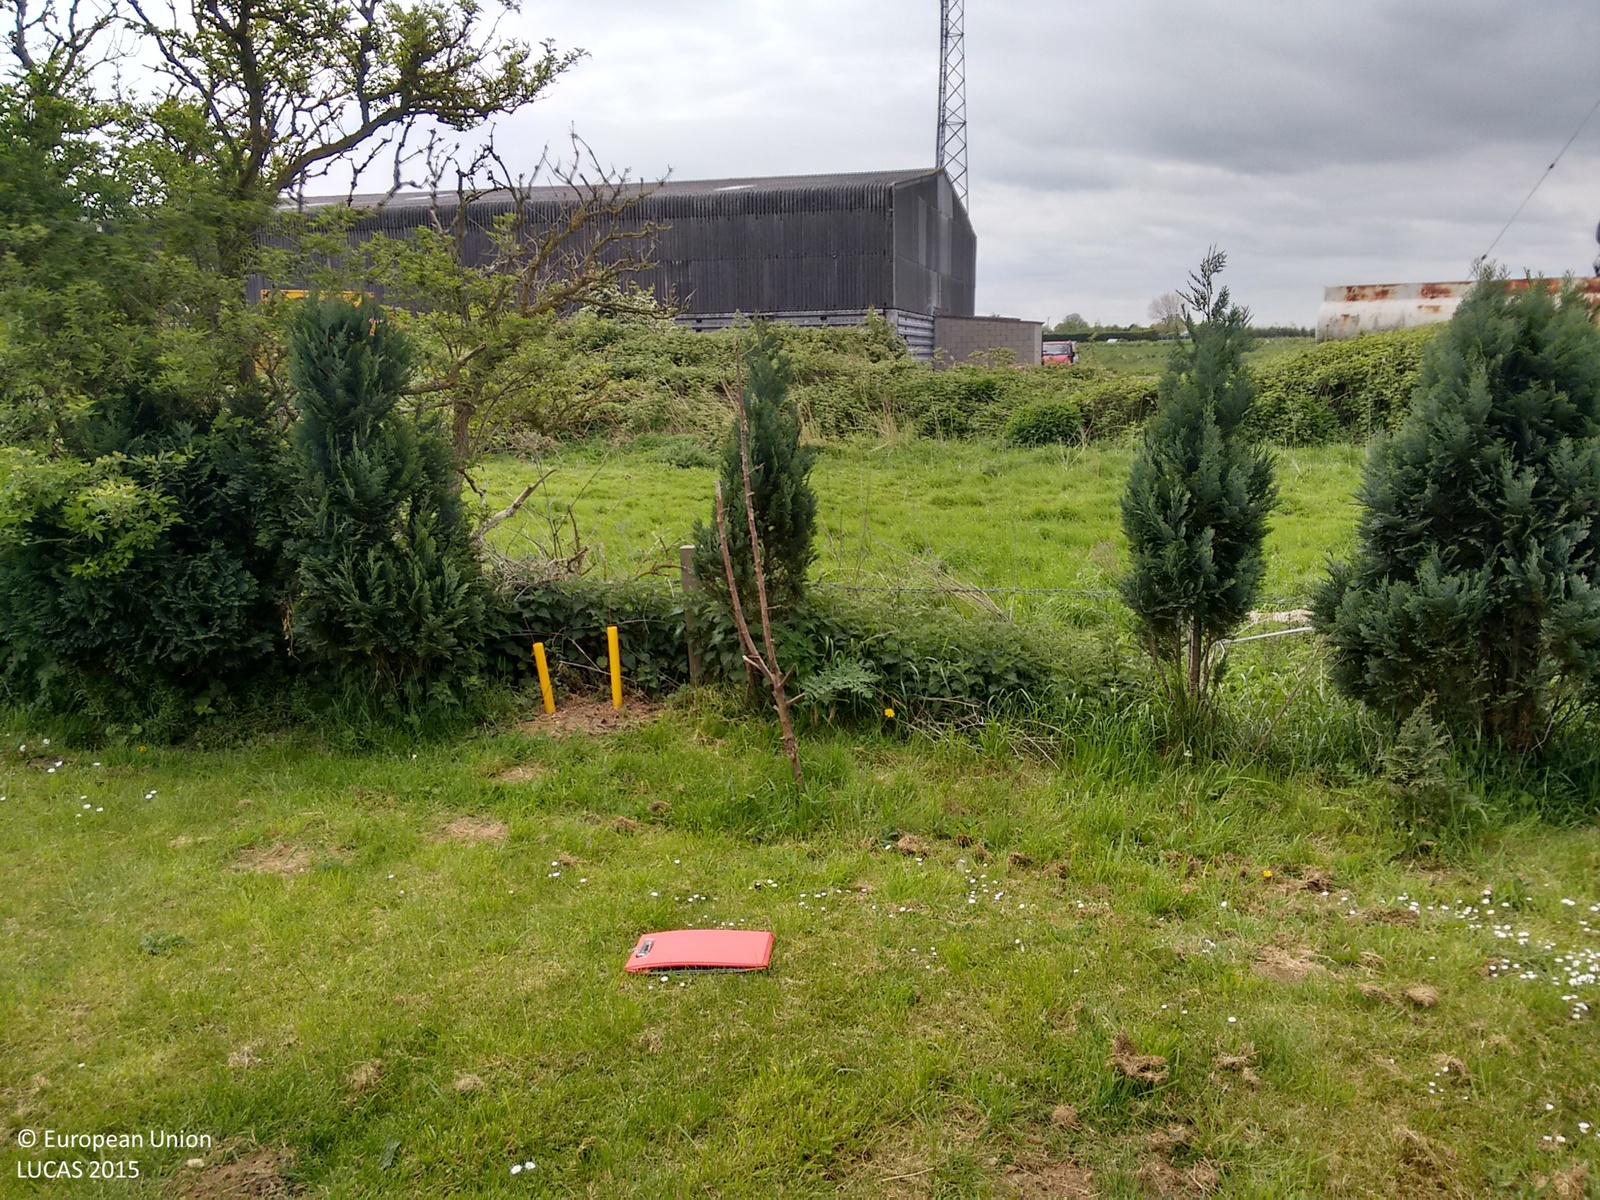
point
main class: Grassland
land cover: Grassland without tree/shrub cover
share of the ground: > 75 %
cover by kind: herbaceous plants 100 %
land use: Residential
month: May
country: GB
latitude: 53.5753
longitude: -0.7476
